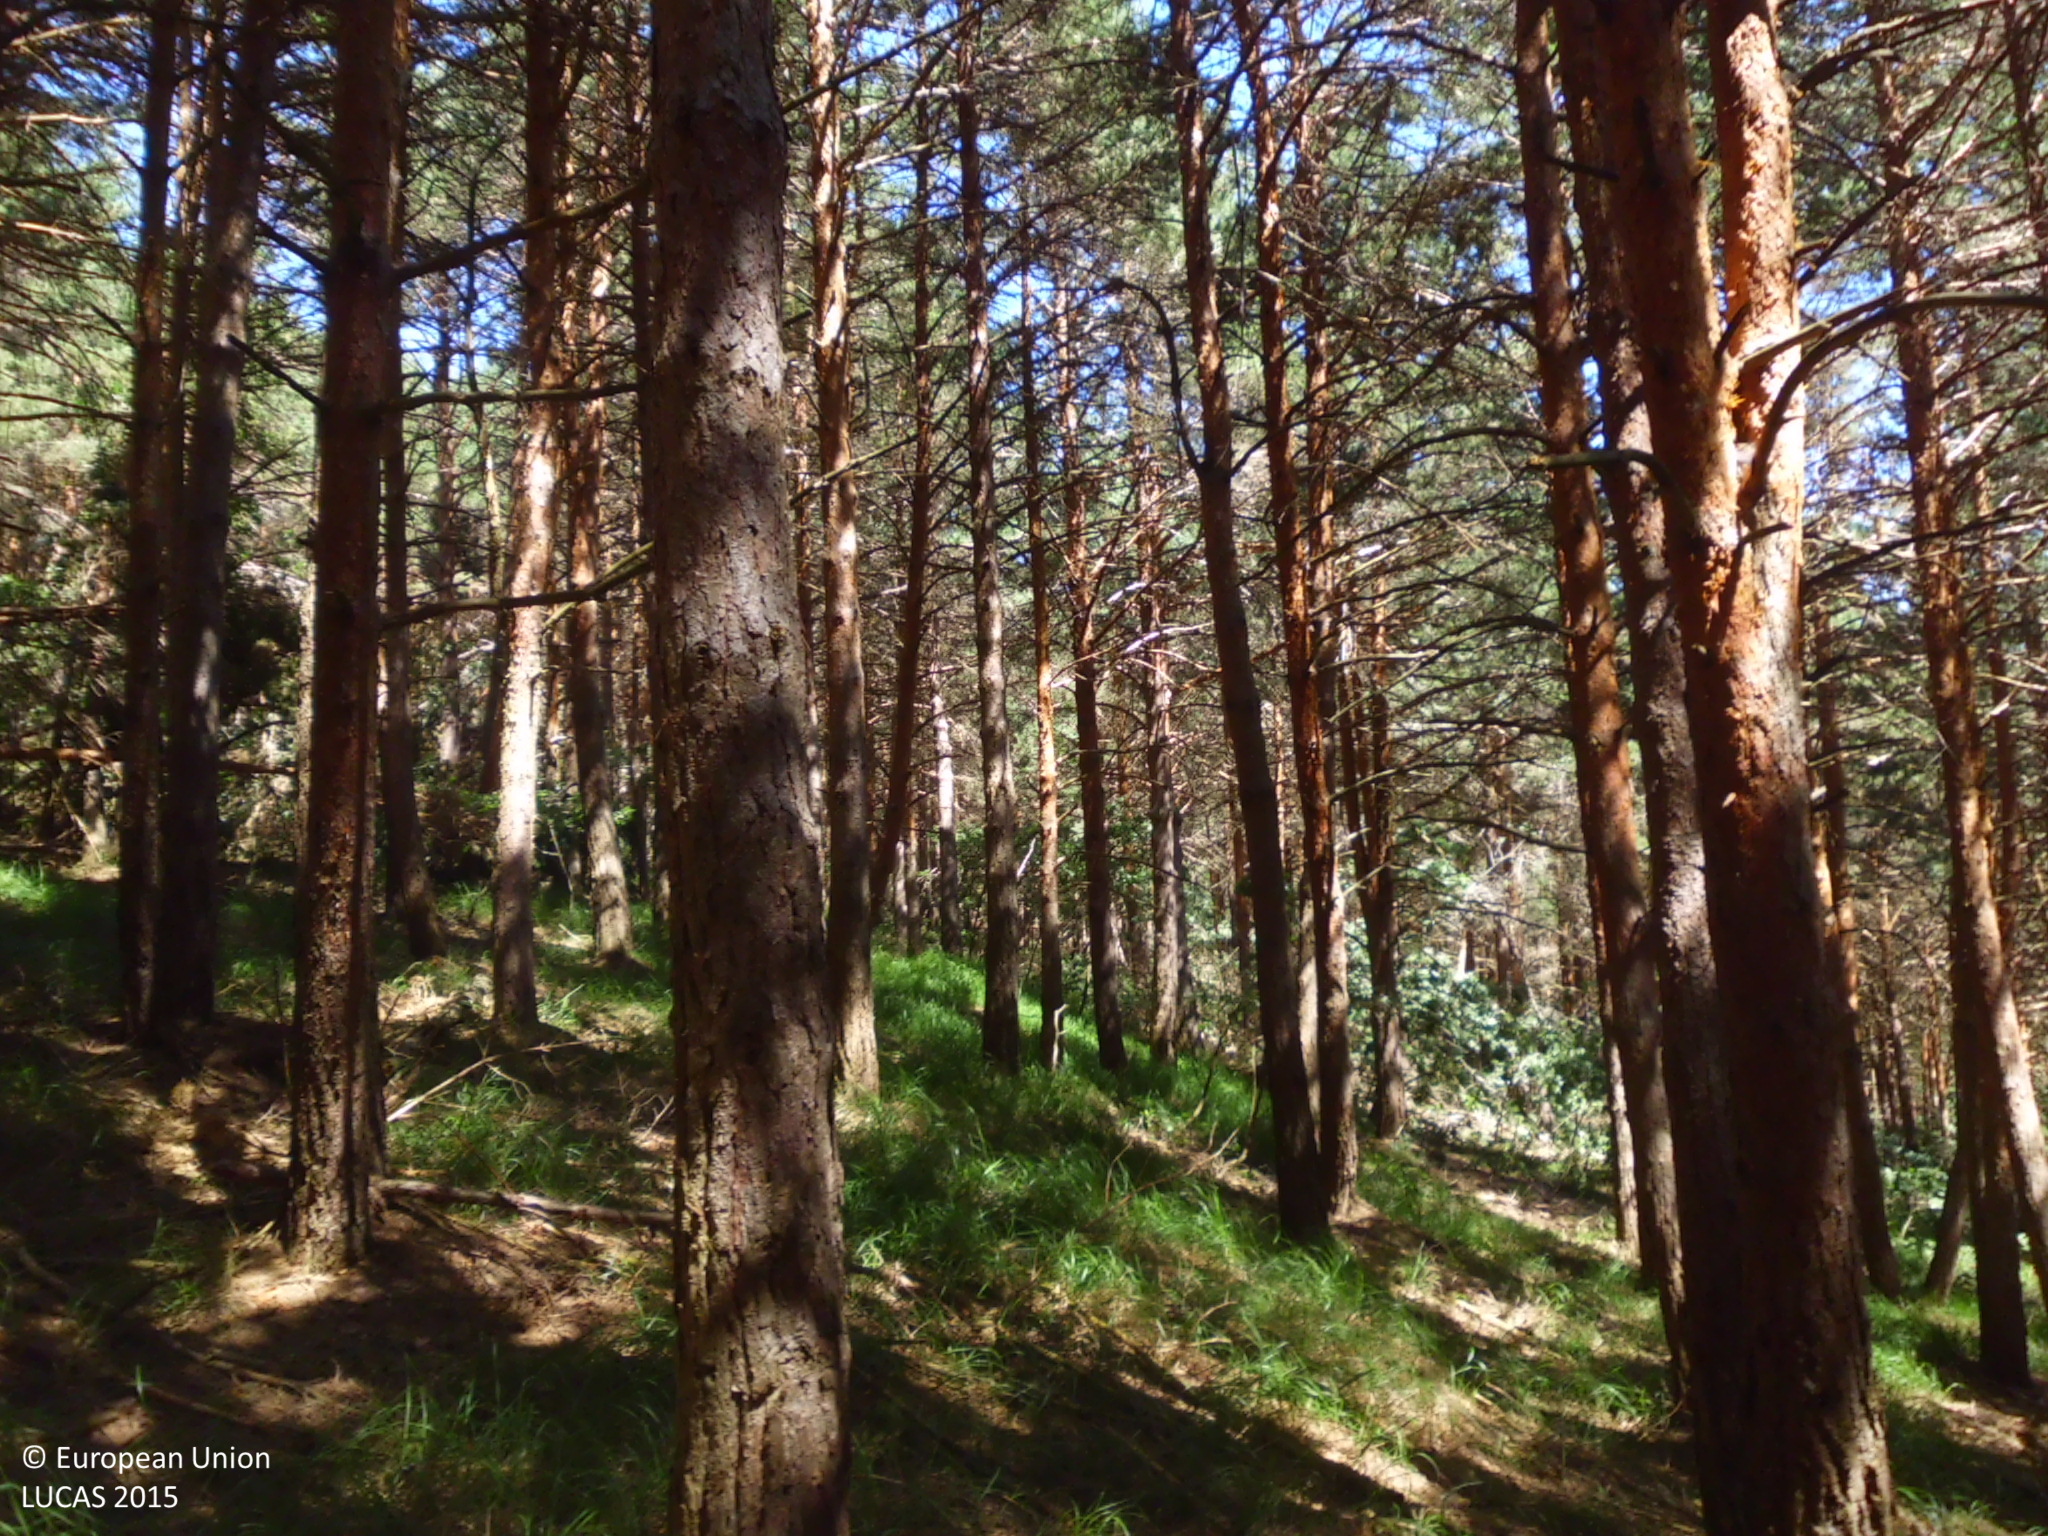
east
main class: Woodland
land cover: Pine dominated coniferous woodland
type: coniferous forest of the mediterranean region
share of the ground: > 75 %
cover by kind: coniferous forest trees 100 %
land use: Forestry
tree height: > 5 m
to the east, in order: Pine dominated coniferous woodland
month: July
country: ES
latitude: 42.8328
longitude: -4.1043
